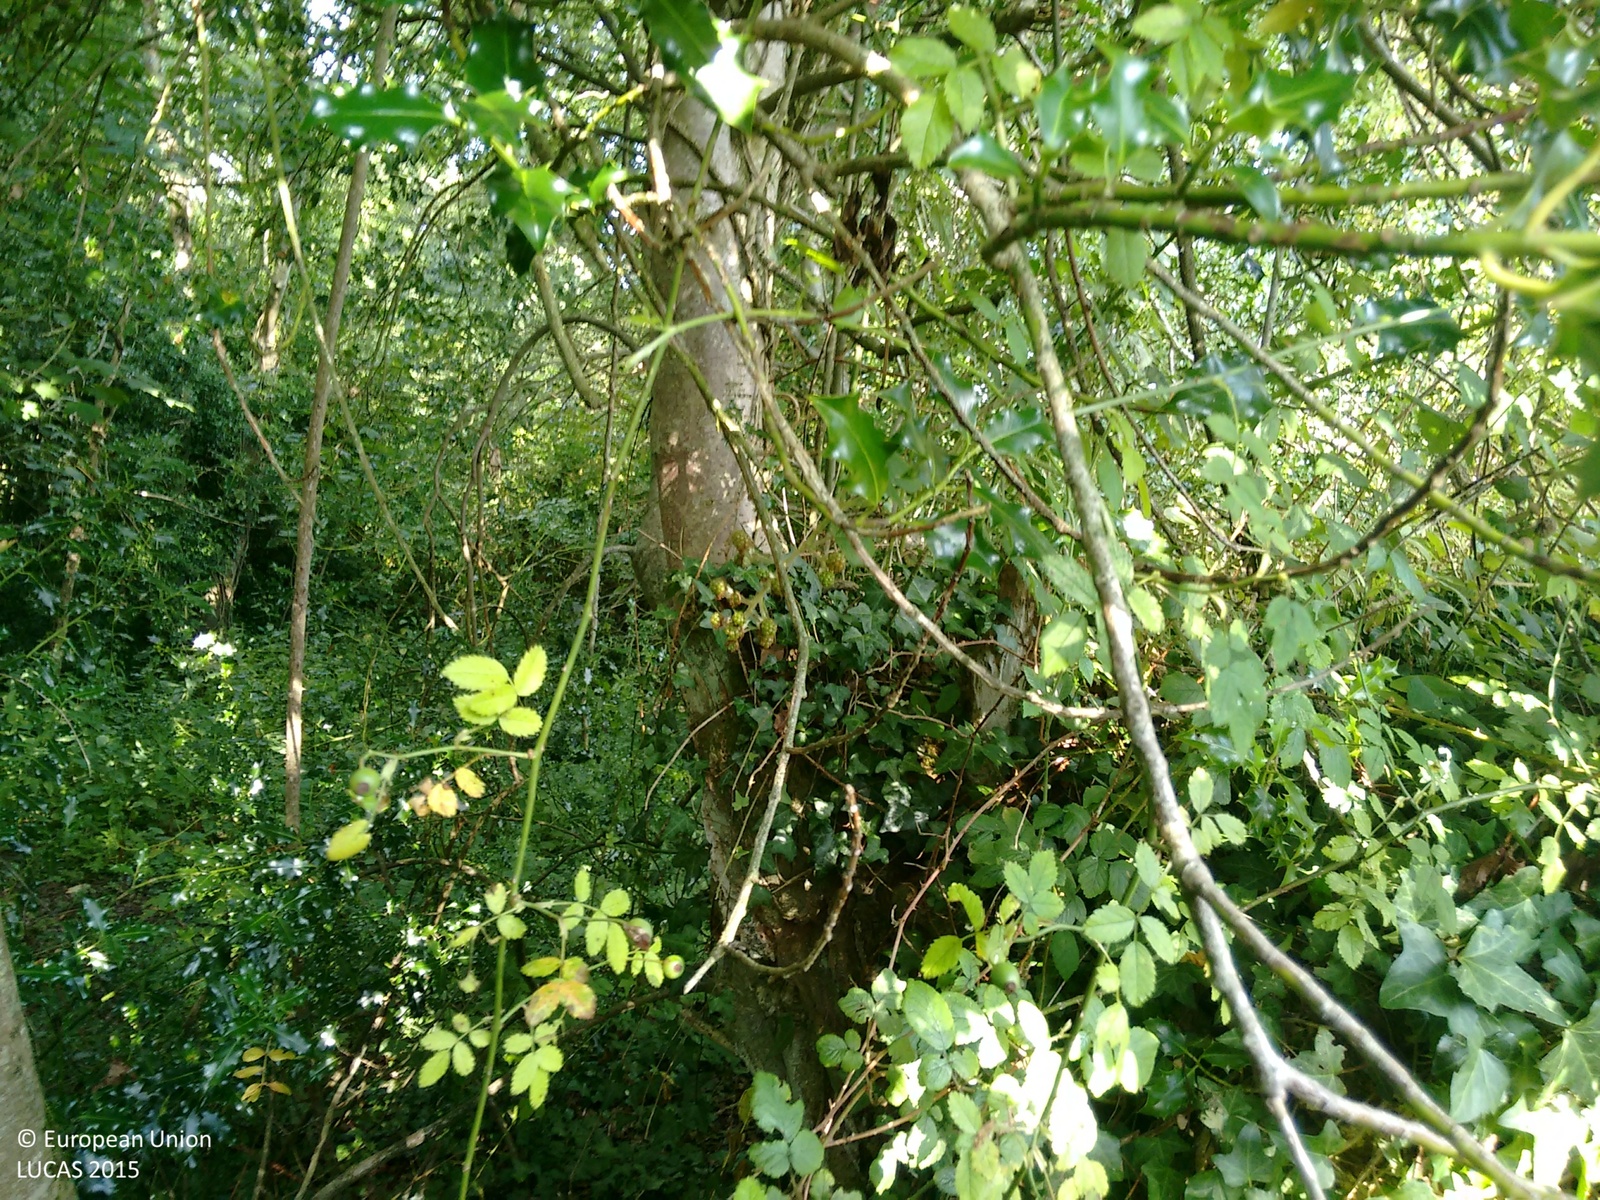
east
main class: Woodland
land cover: Broadleaved woodland
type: acidophilous oak and oak-birch forest
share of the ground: > 75 %
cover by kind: broadleaved forest trees 100 %
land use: Semi-natural and natural areas not in use
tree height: > 5 m
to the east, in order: Broadleaved woodland; Fences; Grassland without tree/shrub cover; Fences; Managed hedges; Paved roads, cycling and walking lanes; Grass margins; Electric lines; Managed hedges; Fences; Grassland without tree/shrub cover
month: September
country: GB
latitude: 50.9897
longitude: -4.1880
